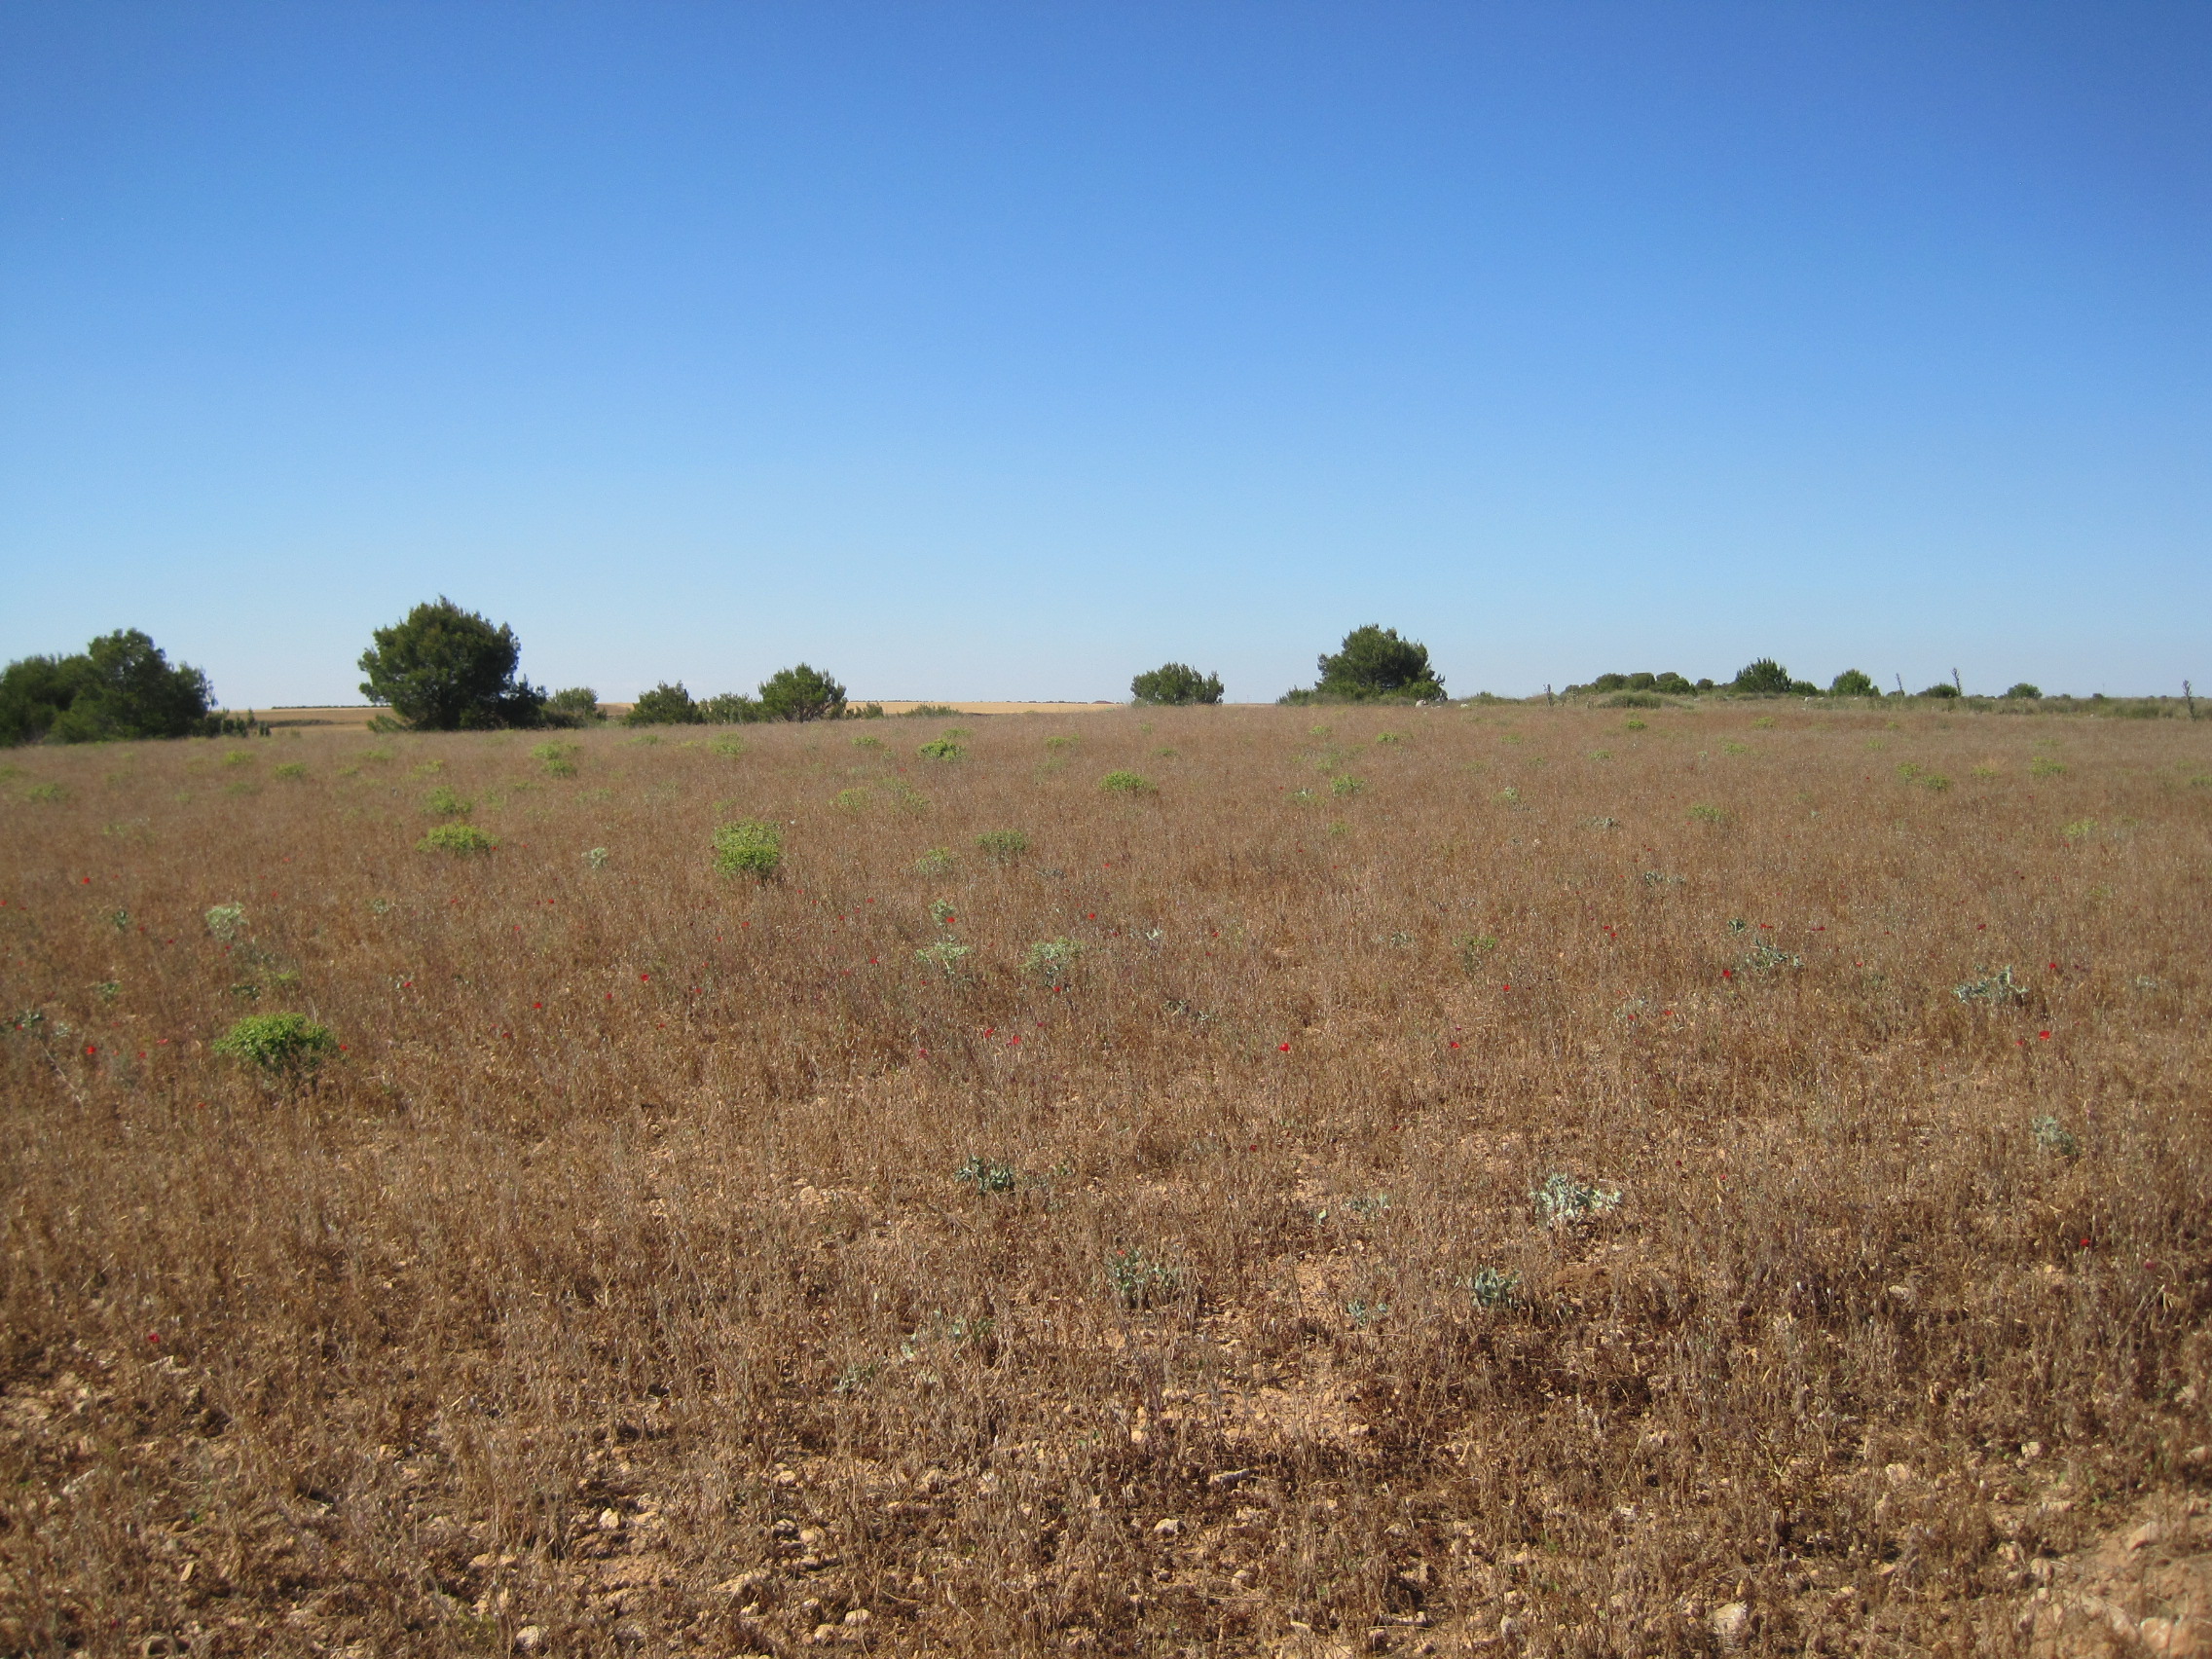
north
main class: Cropland
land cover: Dry pulses
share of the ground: > 75 %
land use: Agriculture (excluding fallow land and kitchen gardens)
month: June
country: ES
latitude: 41.6540
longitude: -5.1468
